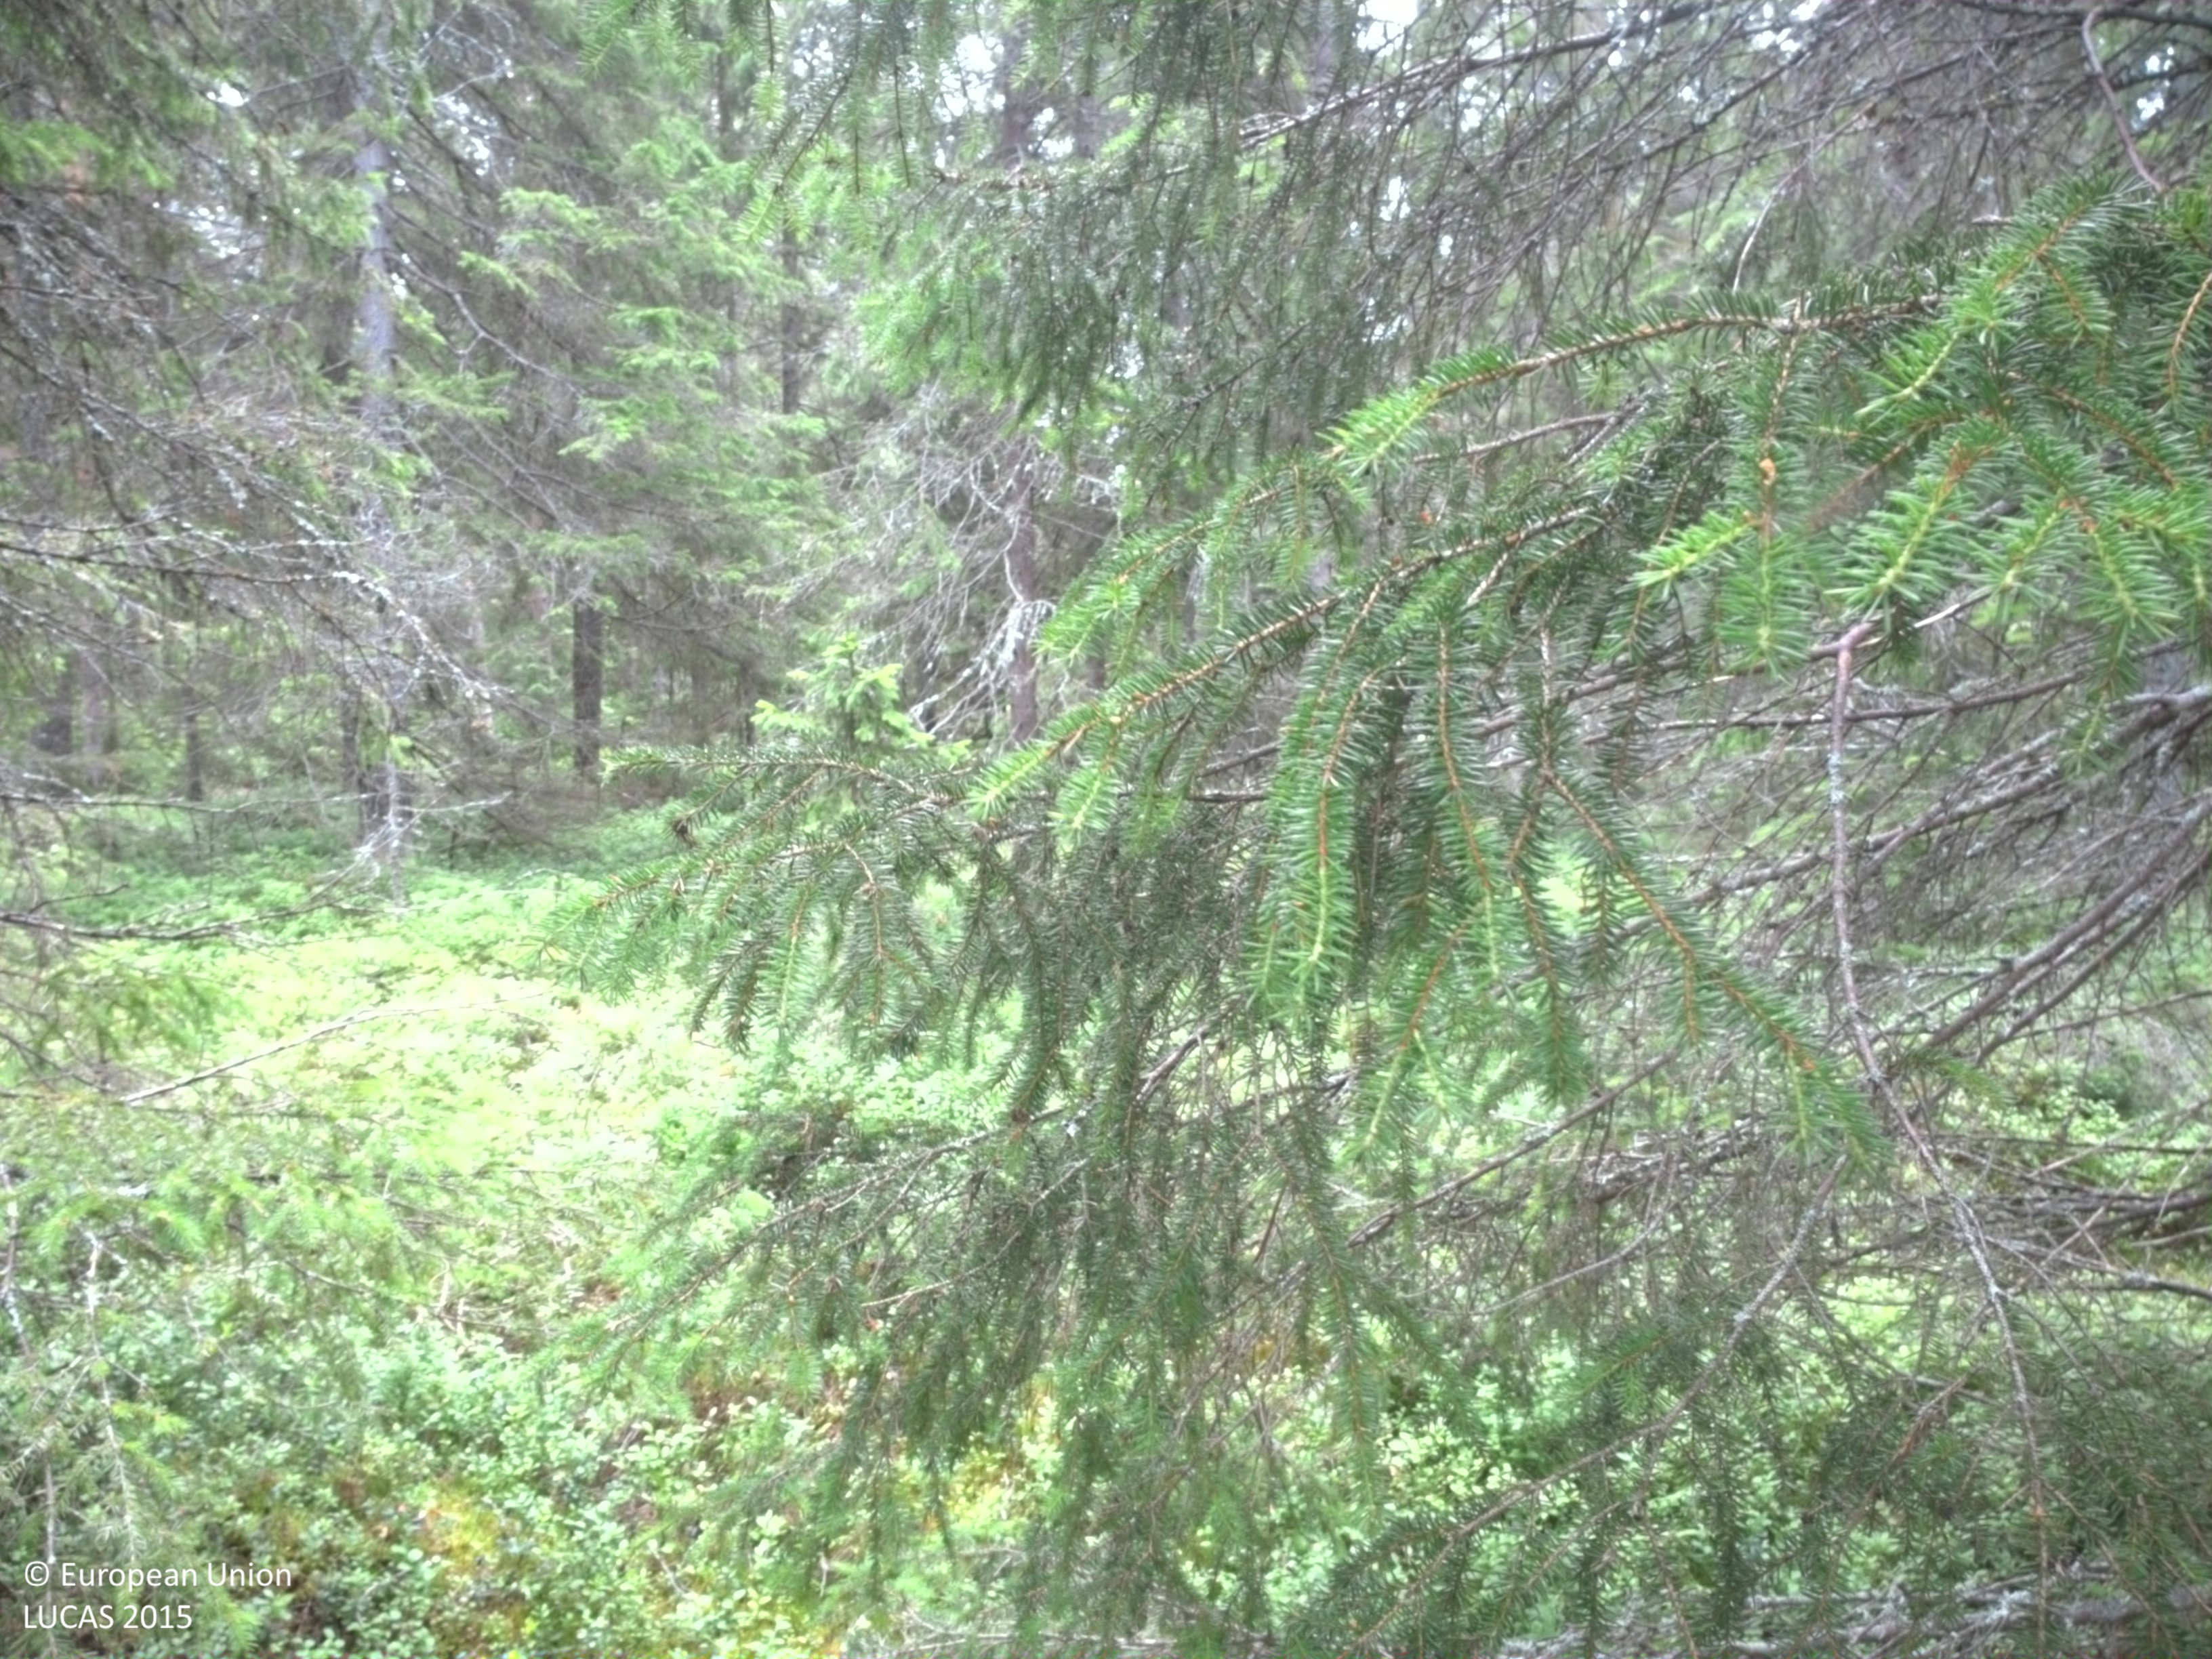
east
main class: Woodland
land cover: Spruce dominated coniferous woodland
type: boreal forest
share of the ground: 50 - 75 %
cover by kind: coniferous forest trees 75 %, shrubs 25 %
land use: Forestry
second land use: Amenities, museums, leisure
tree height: > 5 m
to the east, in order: Spruce dominated coniferous woodland; Paved roads, cycling and walking lanes; Other coniferous woodland; Spruce dominated coniferous woodland; Paved roads, cycling and walking lanes; Spruce dominated coniferous woodland; Artificial constructions in urban areas; Spruce dominated coniferous woodland
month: July
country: SE
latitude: 64.5949
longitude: 21.3265
